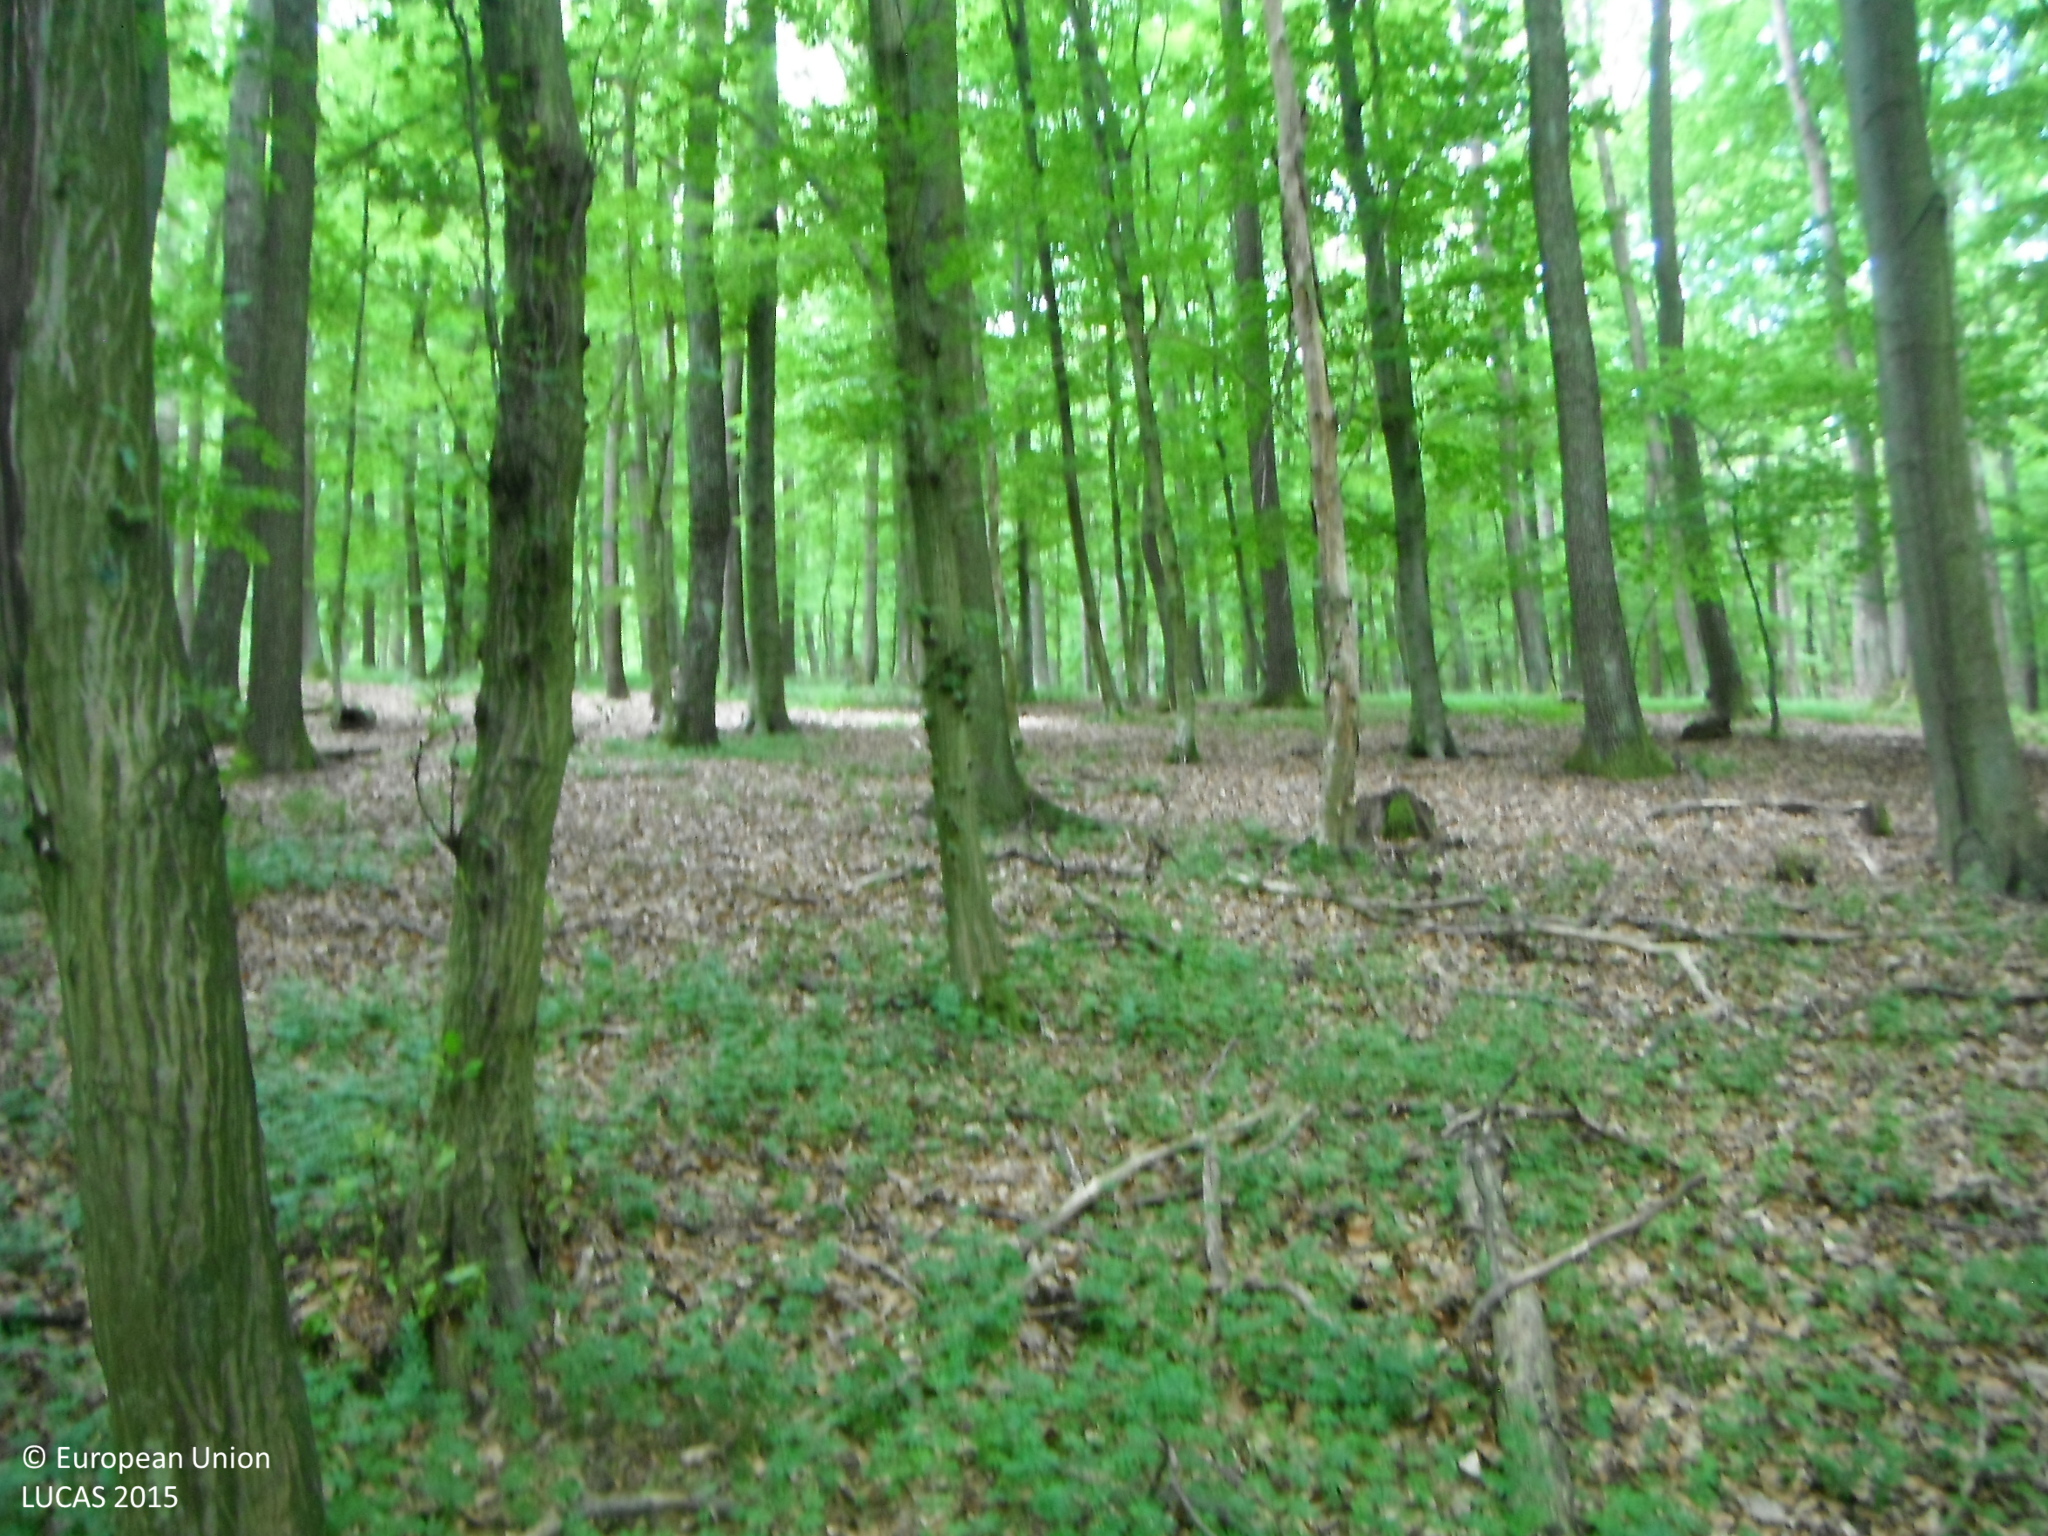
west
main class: Woodland
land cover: Broadleaved woodland
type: mesophytic deciduous forest
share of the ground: > 75 %
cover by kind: broadleaved forest trees 100 %
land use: Forestry
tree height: > 5 m
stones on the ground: < 10 %
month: June
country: SK
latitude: 48.4704
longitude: 18.3068
